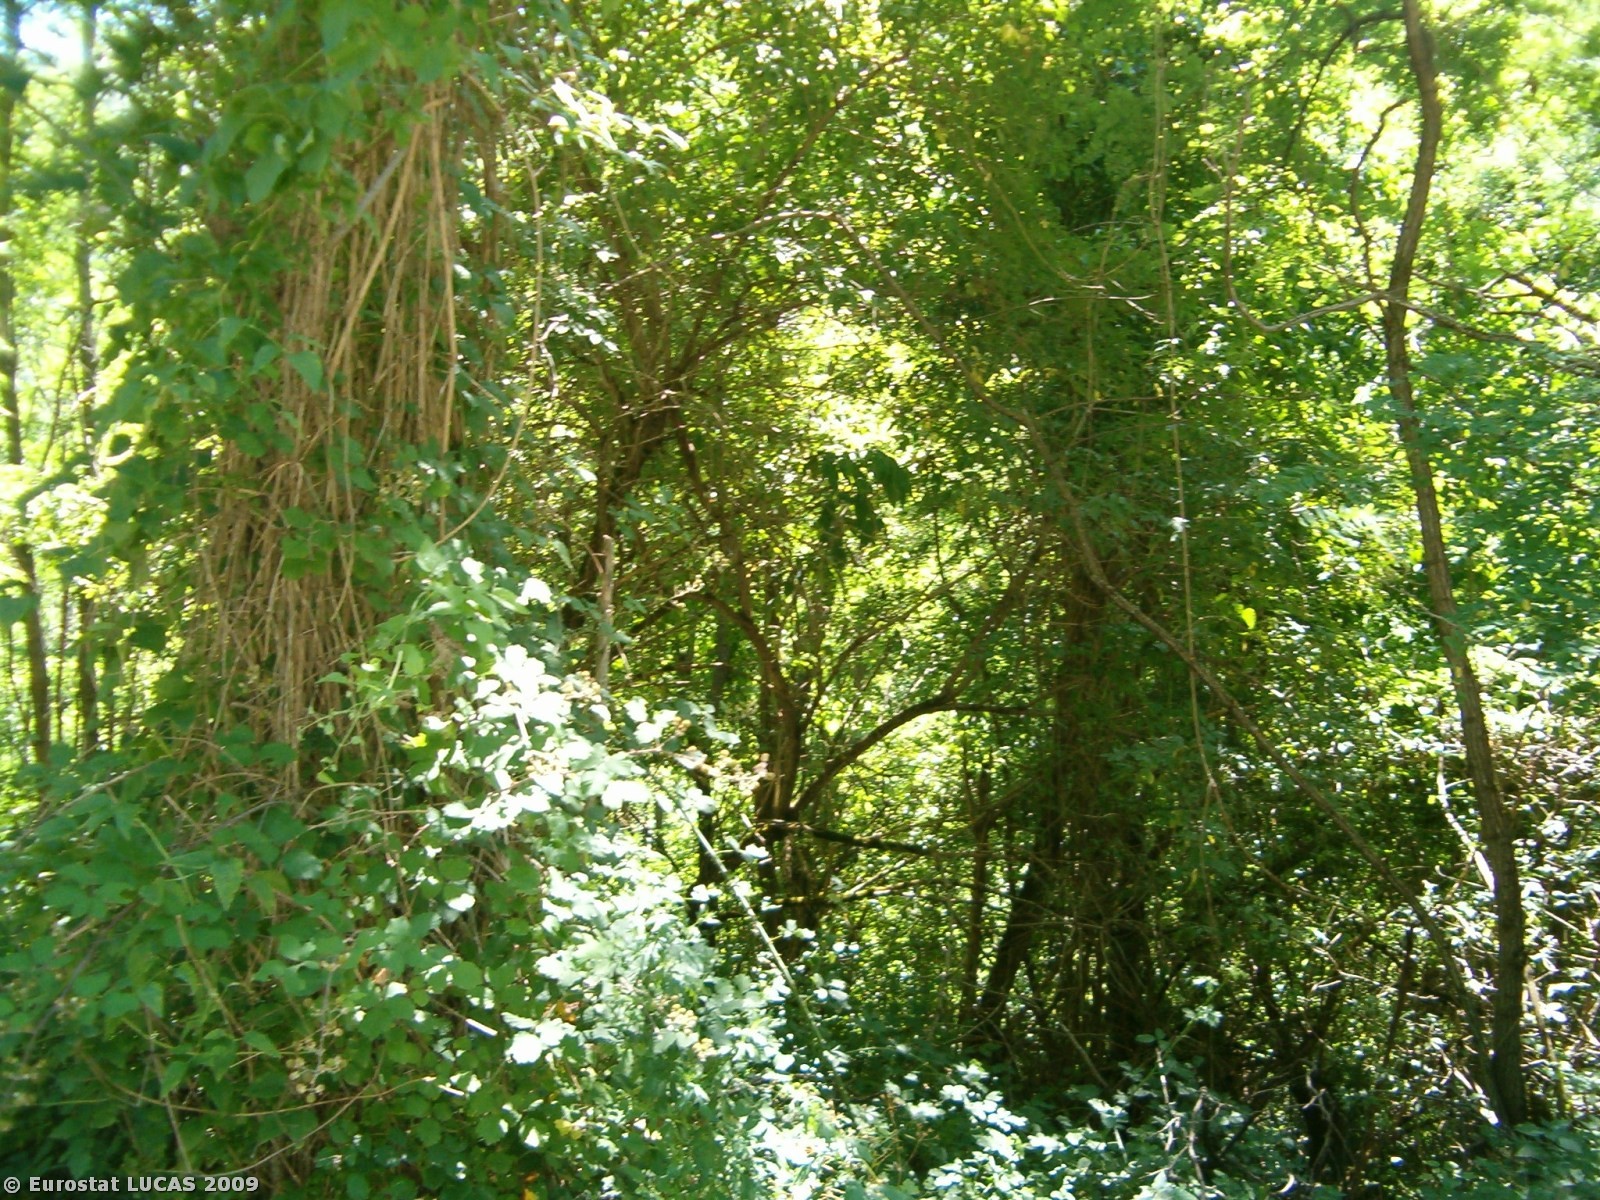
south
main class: Woodland
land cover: Broadleaved woodland
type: thermophilous deciduous forest
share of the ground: > 75 %
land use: Forestry
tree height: > 5 m
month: July
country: IT
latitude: 42.4036
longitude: 13.2336
